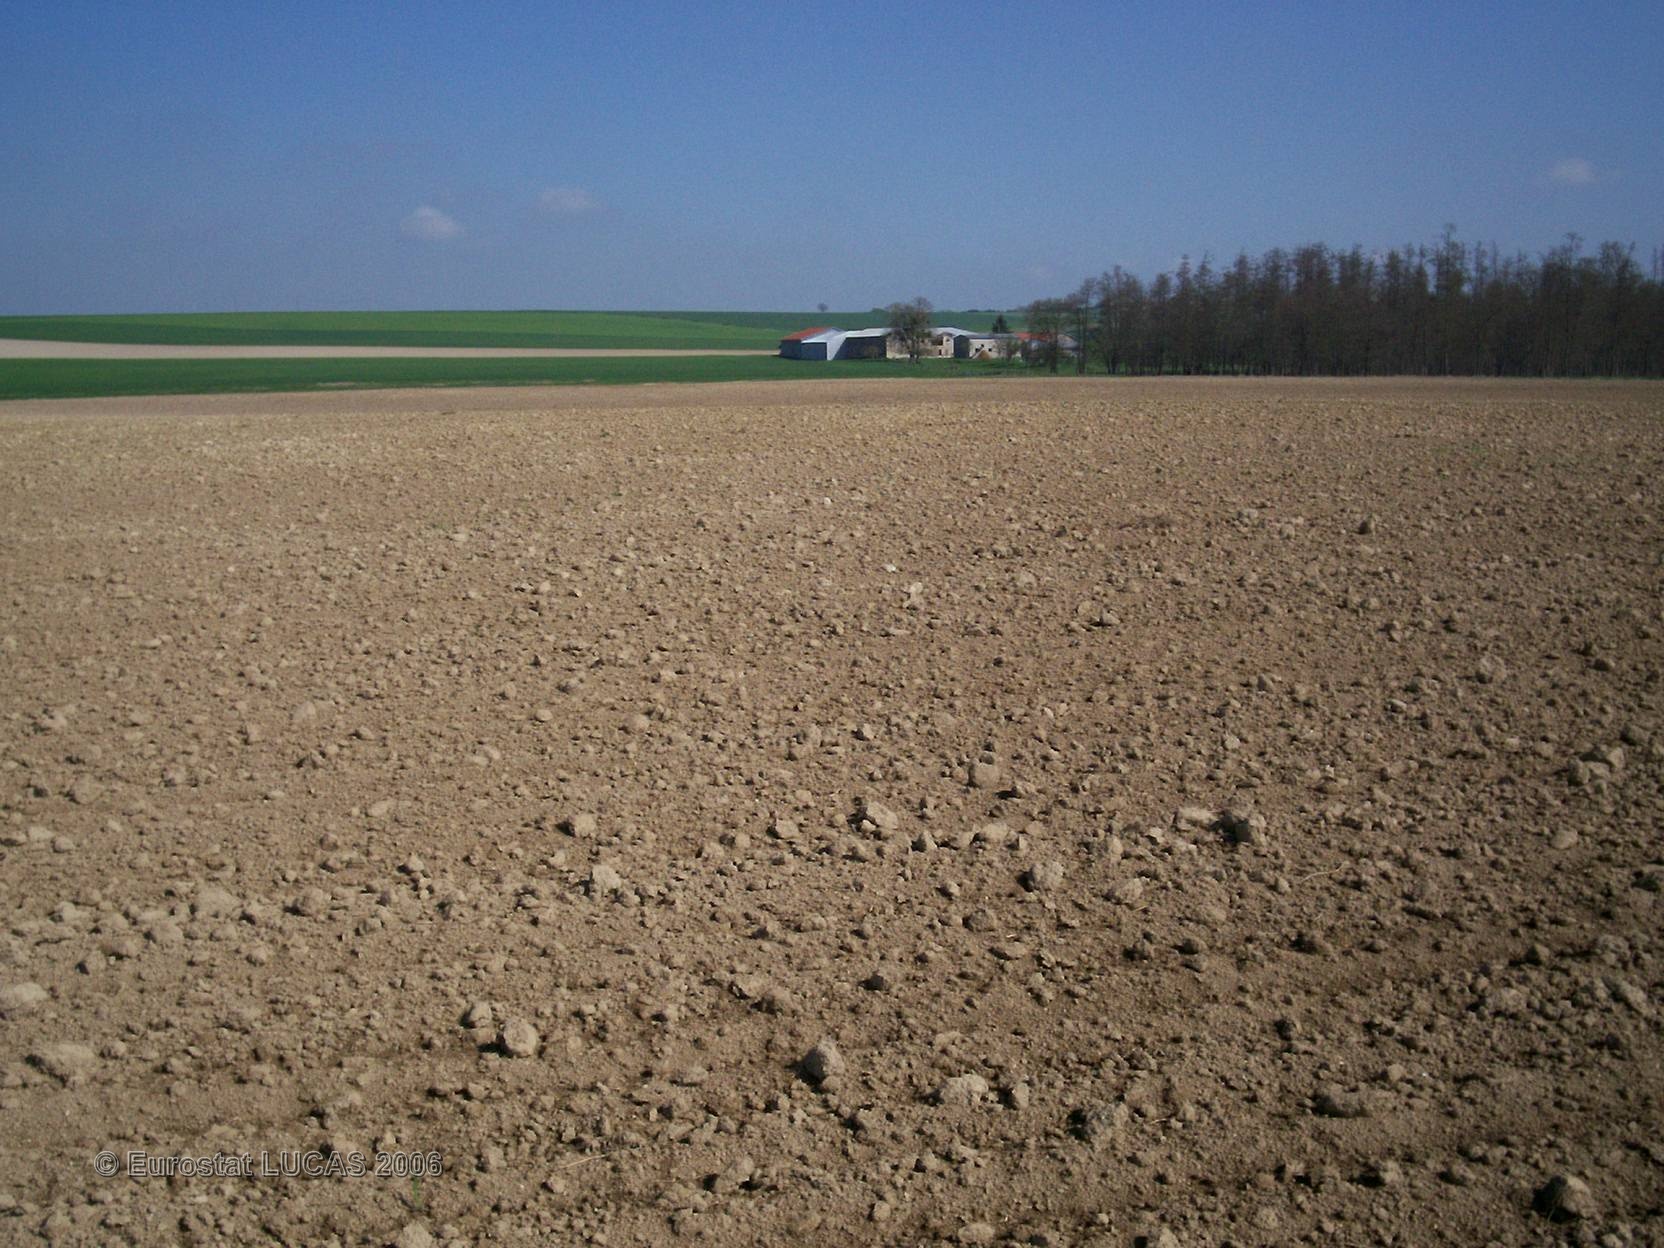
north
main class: Cropland
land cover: Other fibre and oleaginous crops
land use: Agriculture (excluding fallow land and kitchen gardens)
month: May
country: FR
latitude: 48.5377
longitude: 4.5120
